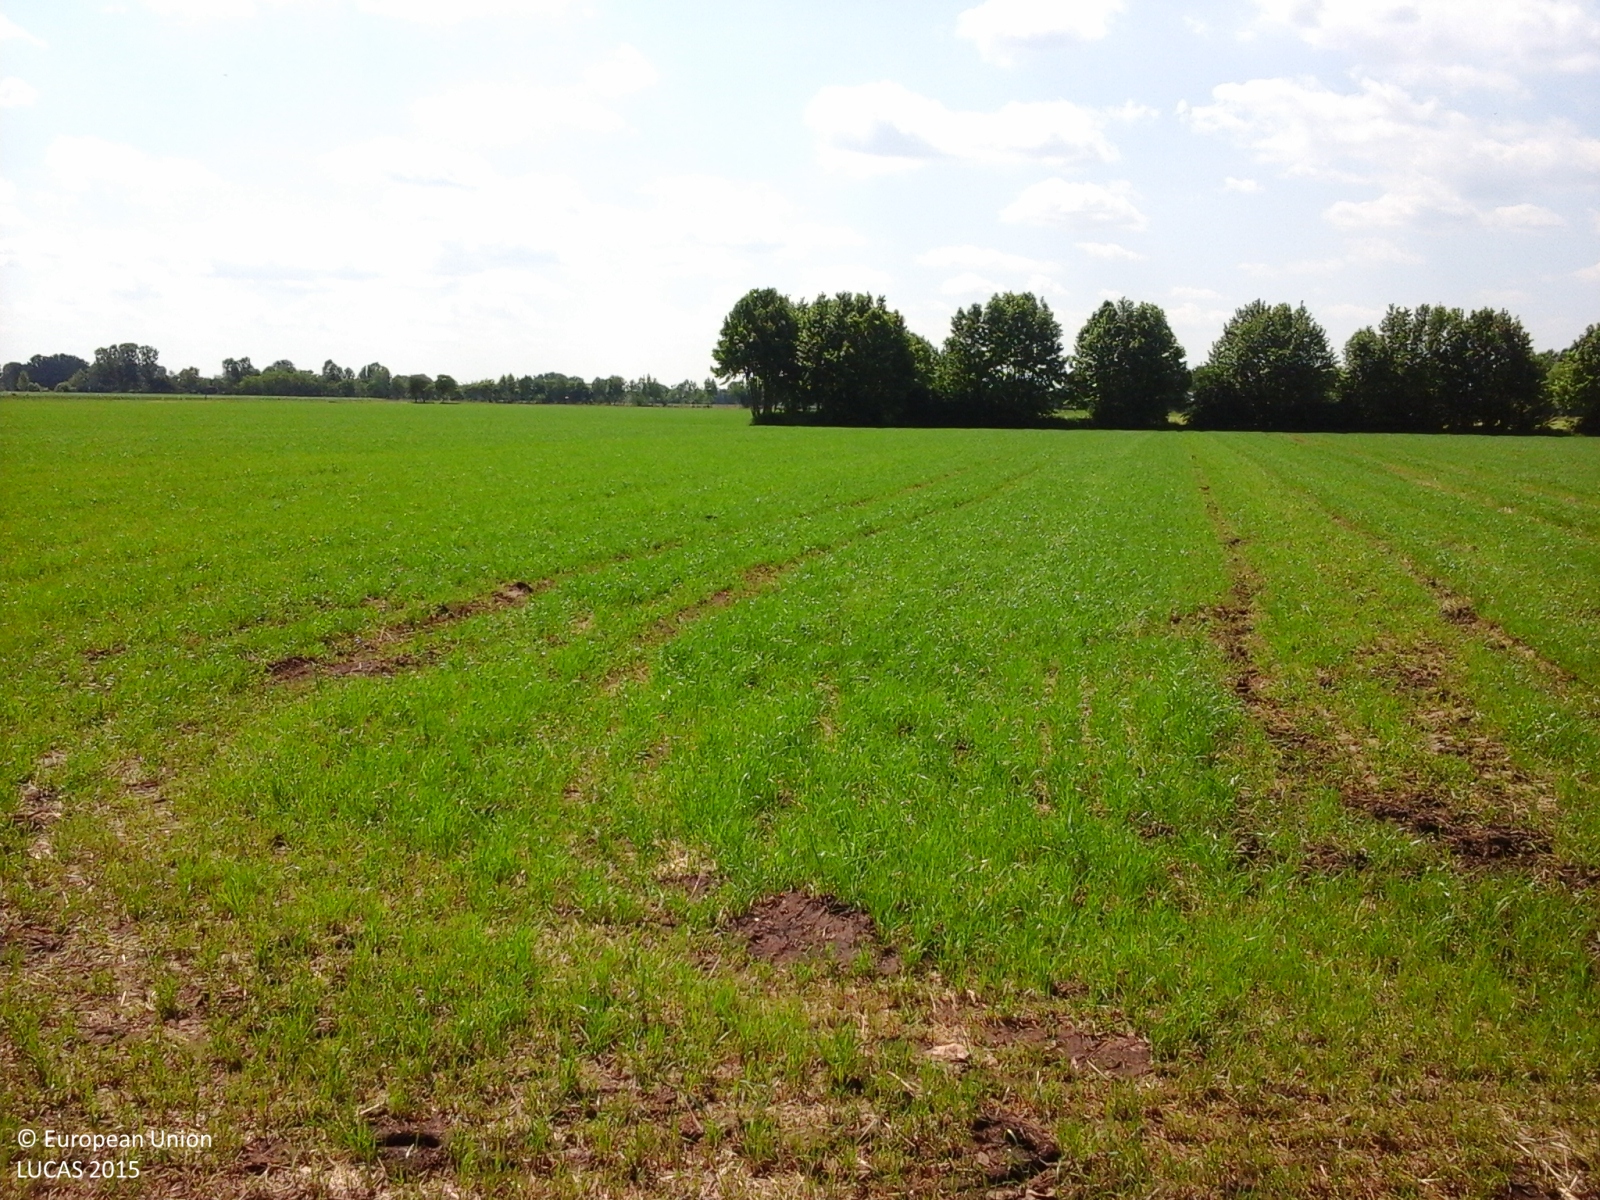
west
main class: Grassland
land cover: Grassland without tree/shrub cover
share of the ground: > 75 %
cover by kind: herbaceous plants 100 %
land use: Agriculture (excluding fallow land and kitchen gardens)
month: May
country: IT
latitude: 45.3419
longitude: 10.2675
